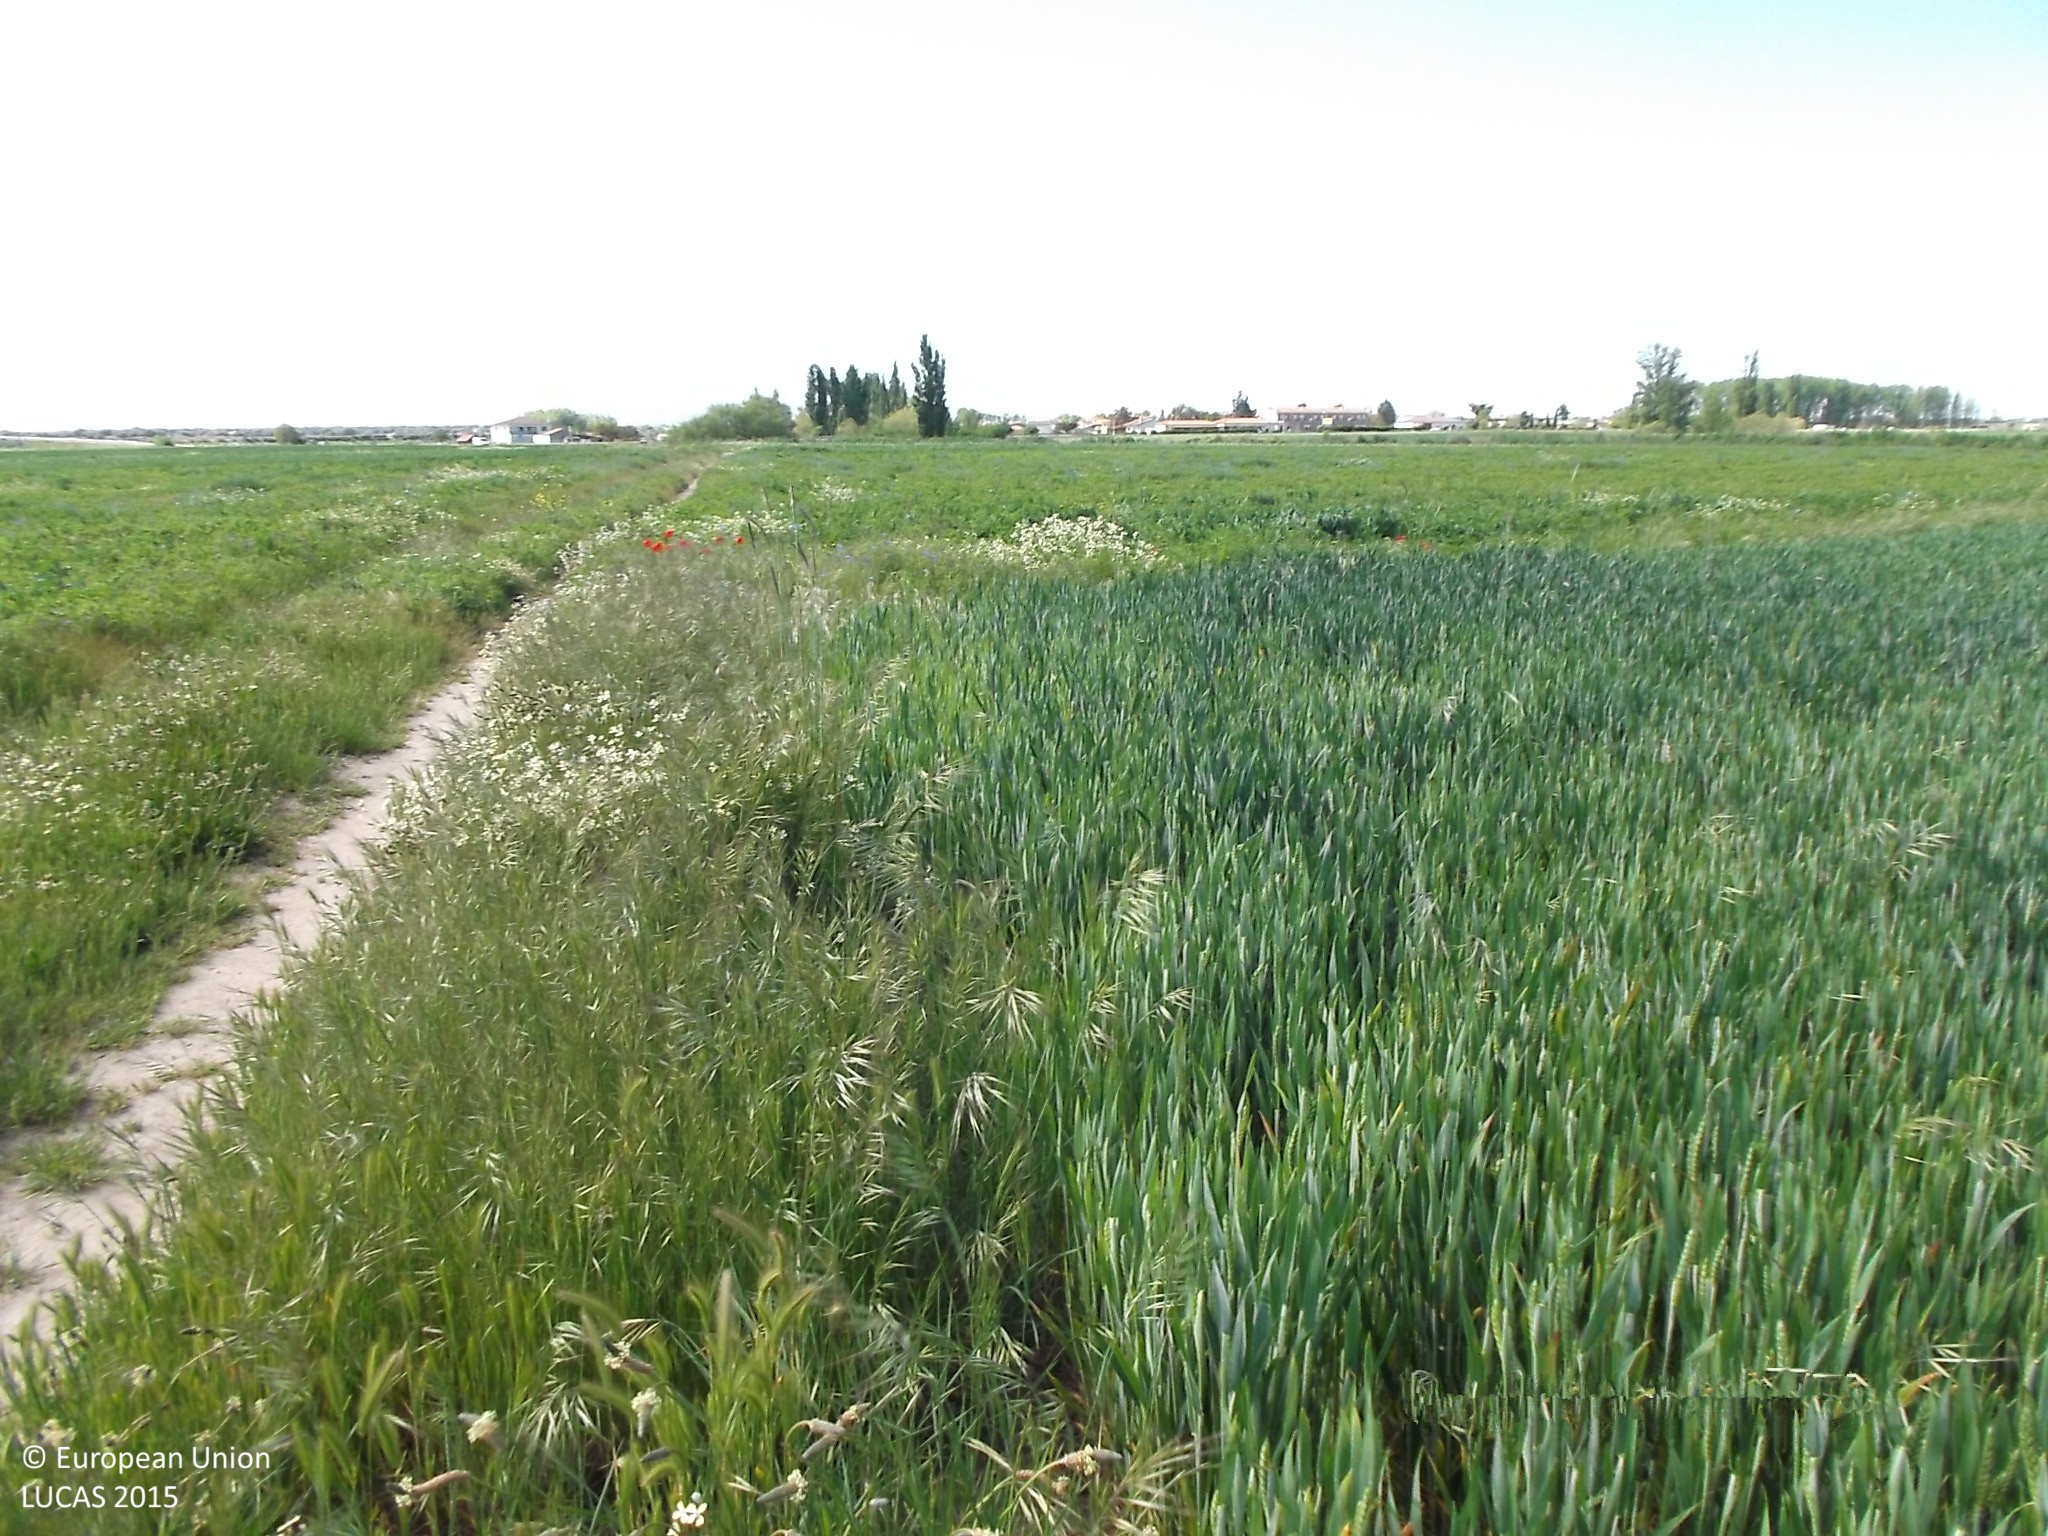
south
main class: Cropland
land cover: Common wheat
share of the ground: > 75 %
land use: Agriculture (excluding fallow land and kitchen gardens)
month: May
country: ES
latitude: 40.8034
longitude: -6.2185
